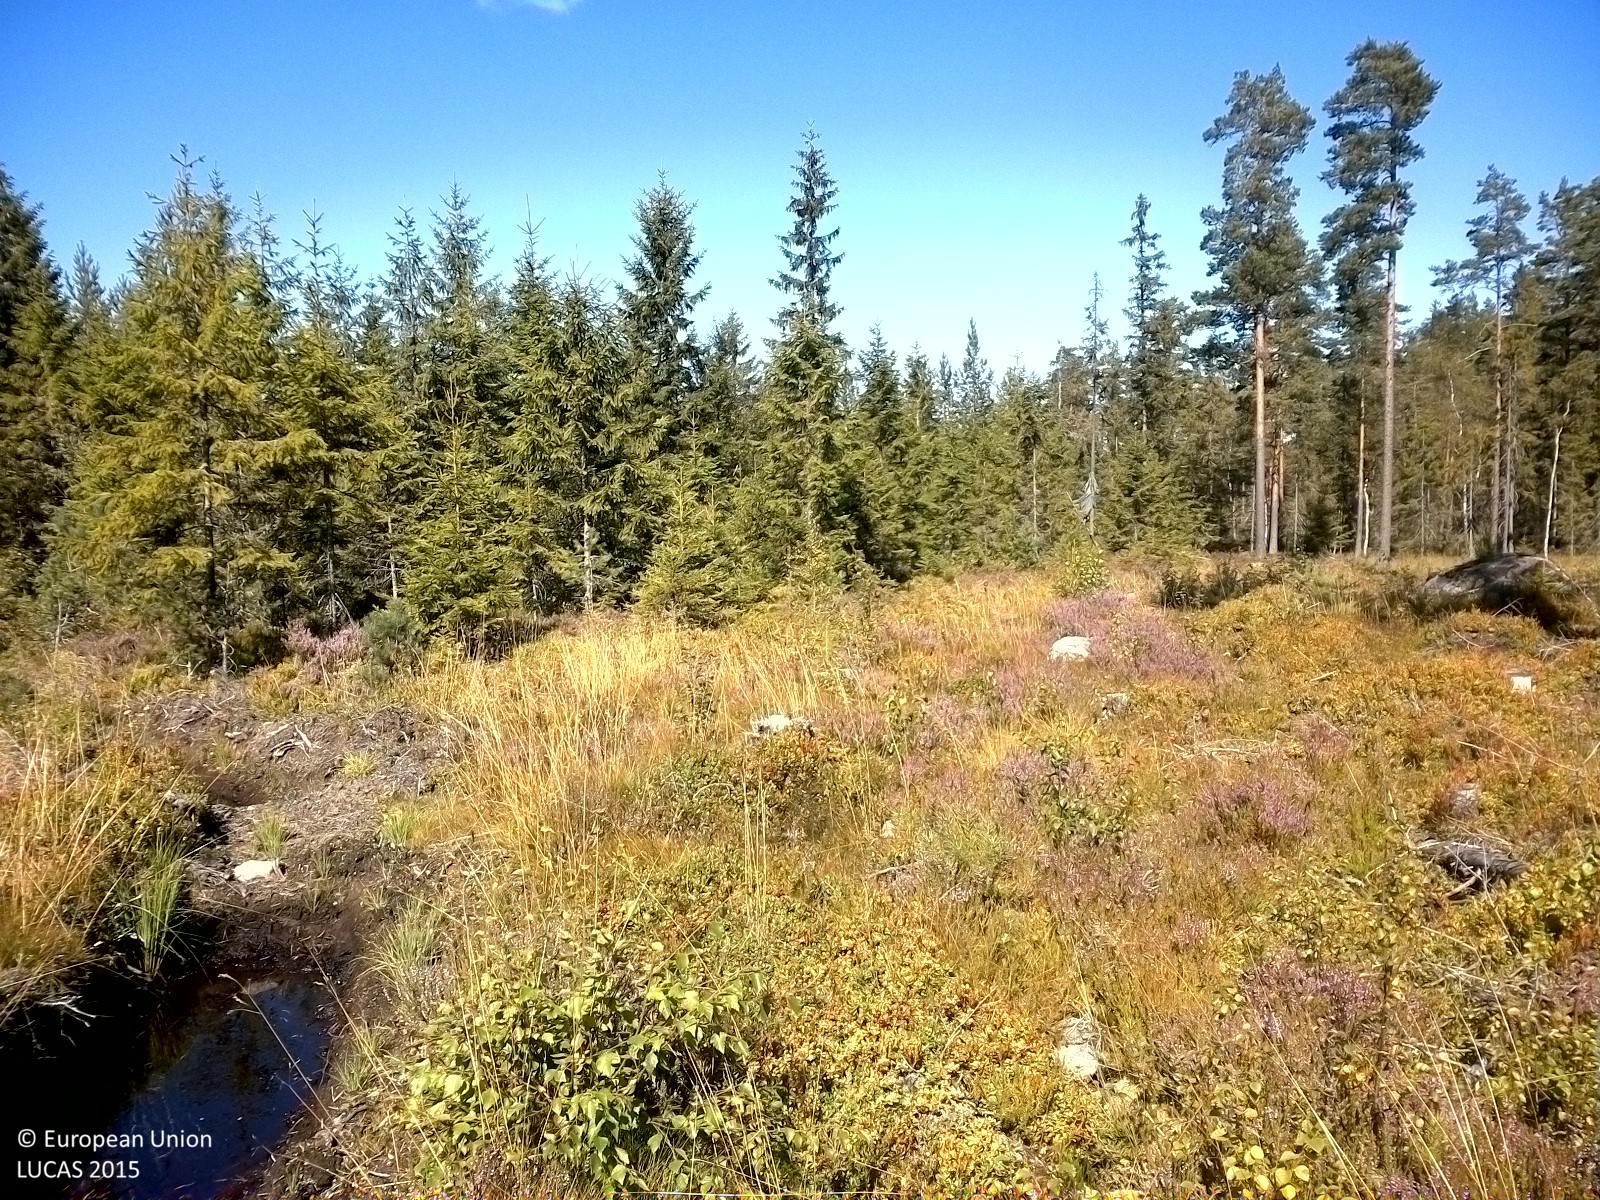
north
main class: Woodland
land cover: Pine dominated coniferous woodland
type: boreal forest
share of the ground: 10 - 25 %
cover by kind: shrubs 45 %, herbaceous plants 25 %, coniferous forest trees 15 %, lichens and mosses 15 %
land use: Forestry
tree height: > 5 m
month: August
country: SE
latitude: 59.4173
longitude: 14.6960
